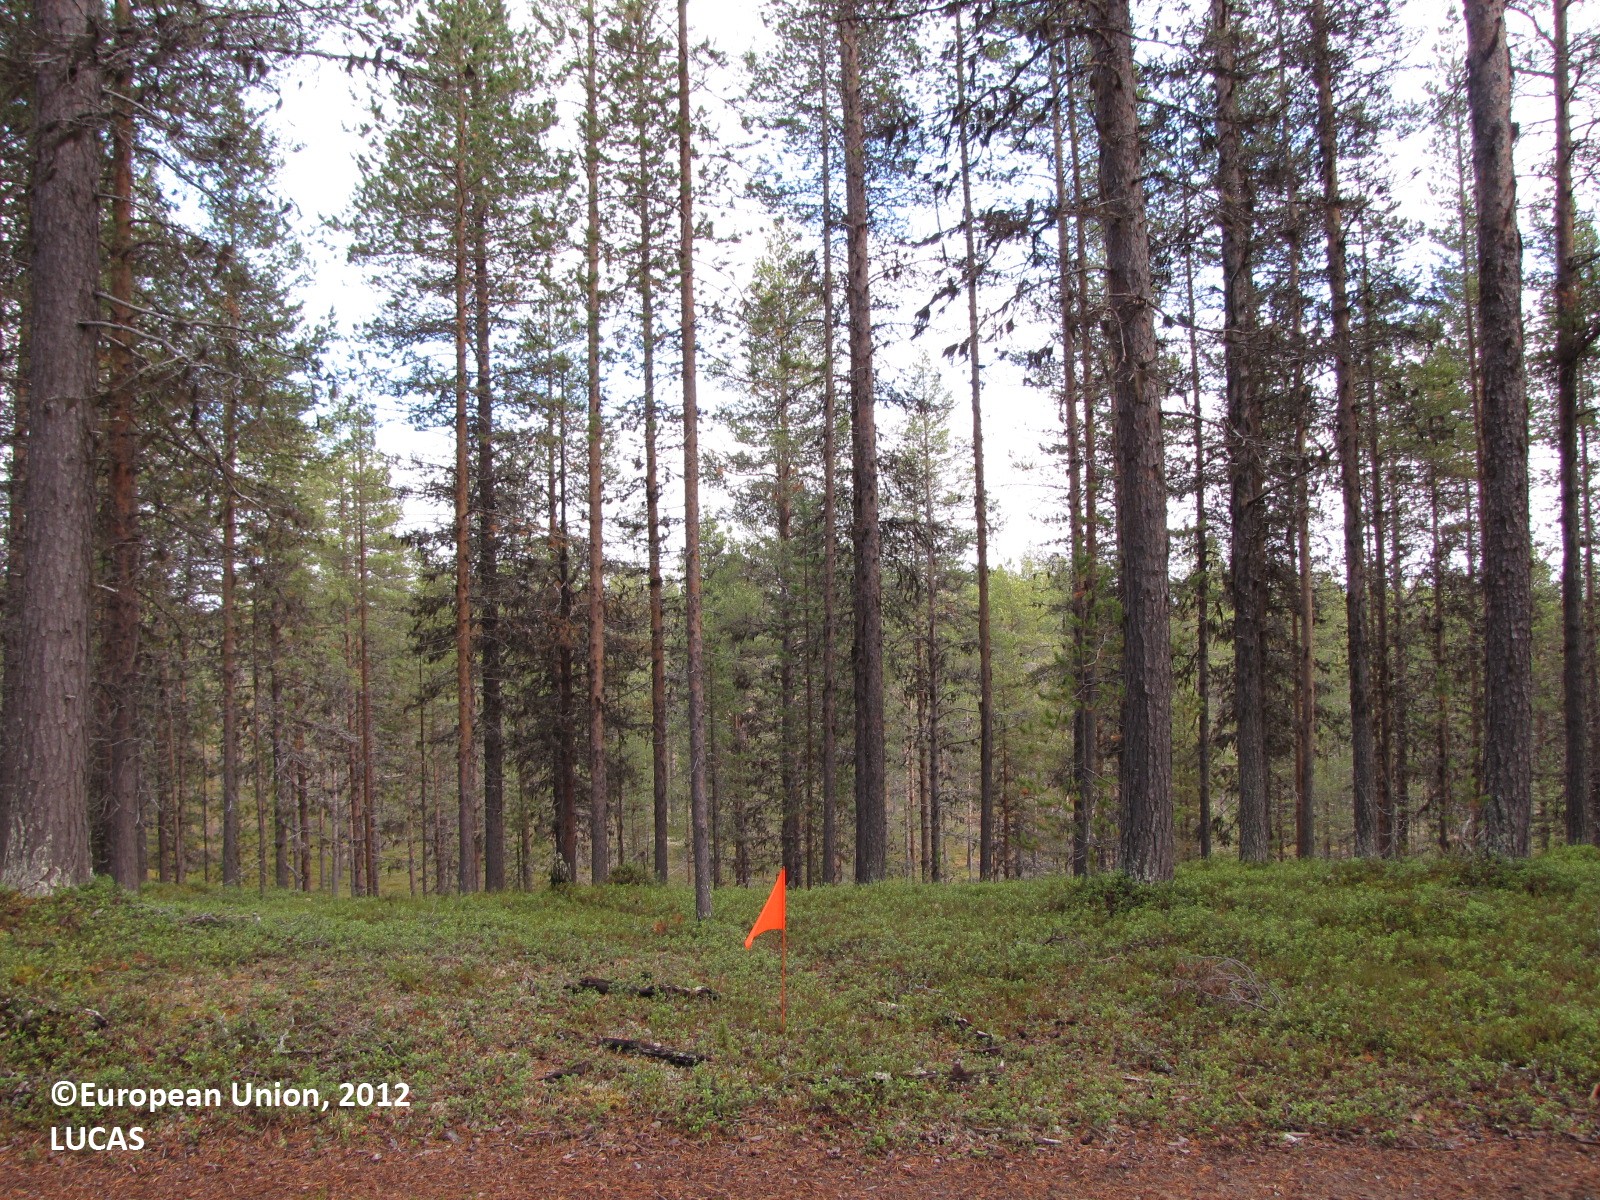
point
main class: Woodland
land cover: Pine dominated coniferous woodland
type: boreal forest
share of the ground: 25 - 50 %
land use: Forestry
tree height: > 5 m
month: September
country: FI
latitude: 67.8669
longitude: 23.5448
